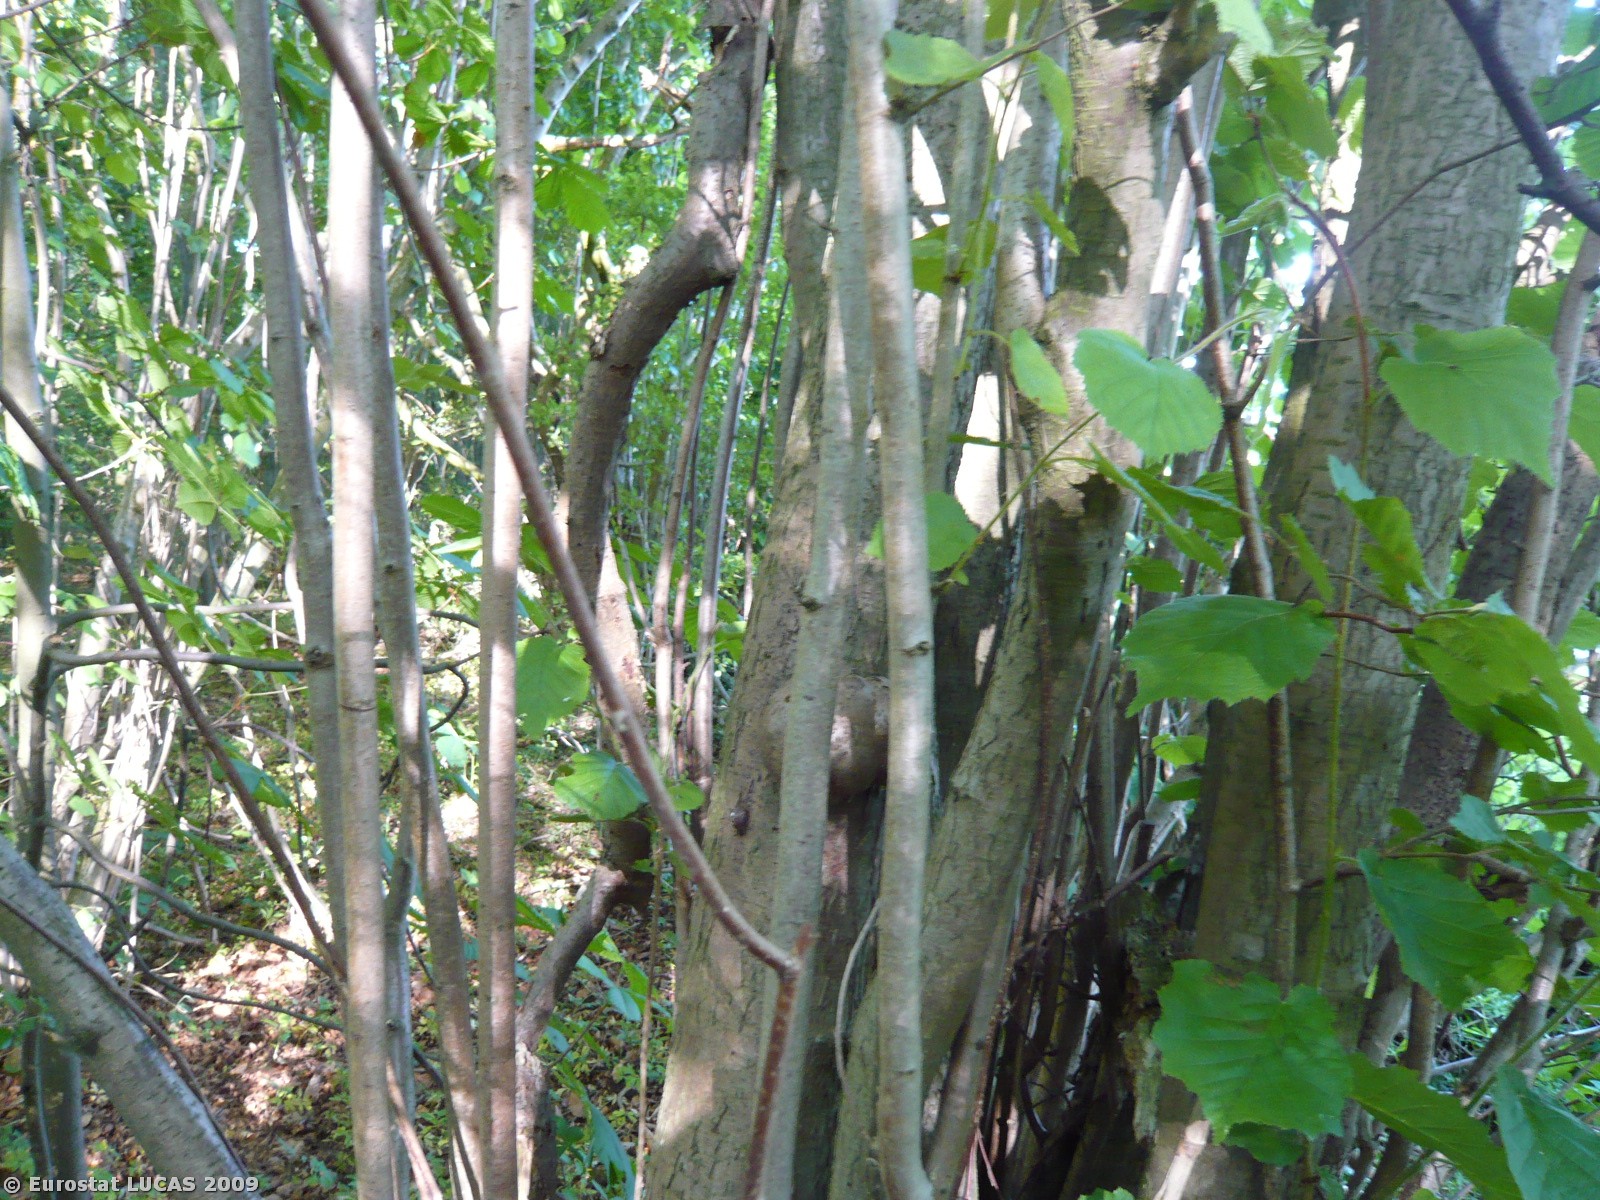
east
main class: Woodland
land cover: Broadleaved woodland
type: mesophytic deciduous forest
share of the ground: > 75 %
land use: Amenities, museums, leisure
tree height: > 5 m
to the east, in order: Broadleaved woodland; Grass margins; Tracks; Grass margins; Paved roads, cycling and walking lanes; Common wheat; Broadleaved woodland; Fences; Artificial constructions in urban areas
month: June
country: DK
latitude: 54.8785
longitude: 11.9470
